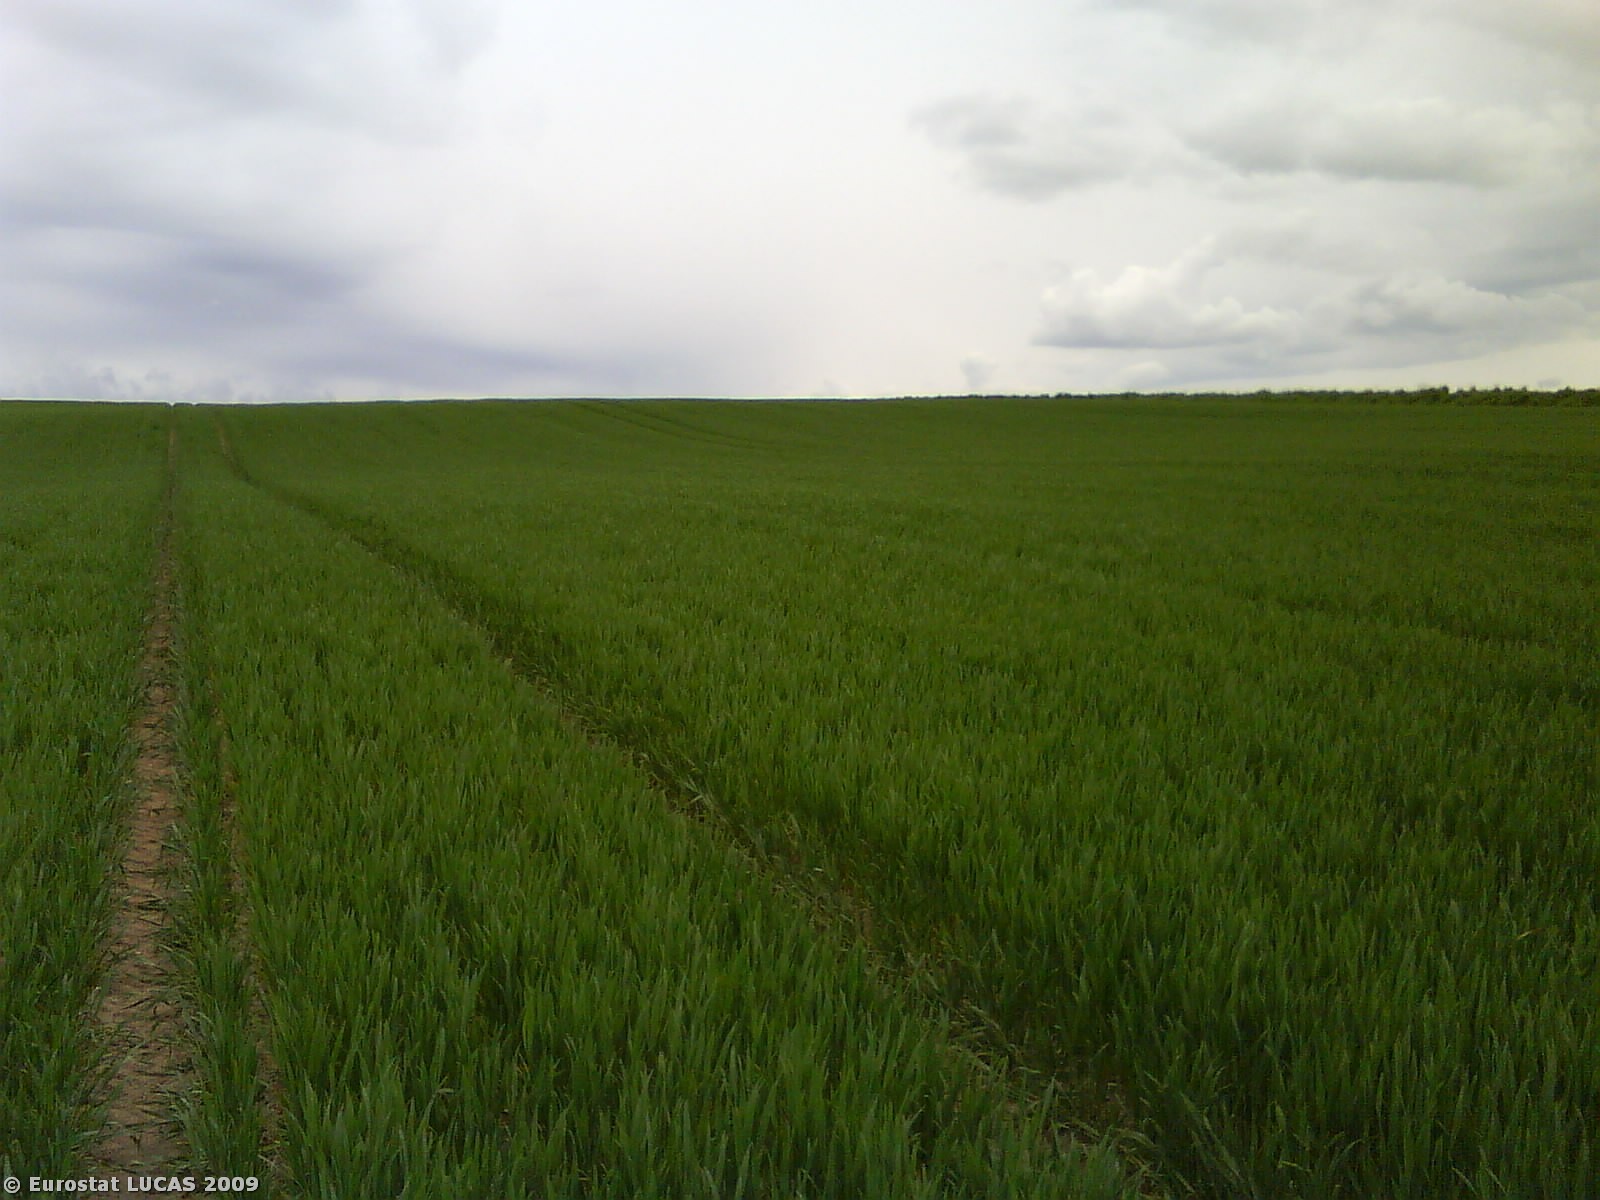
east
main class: Cropland
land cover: Common wheat
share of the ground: > 75 %
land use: Agriculture (excluding fallow land and kitchen gardens)
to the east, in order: Common wheat
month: May
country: DK
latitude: 56.4212
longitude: 10.2429
